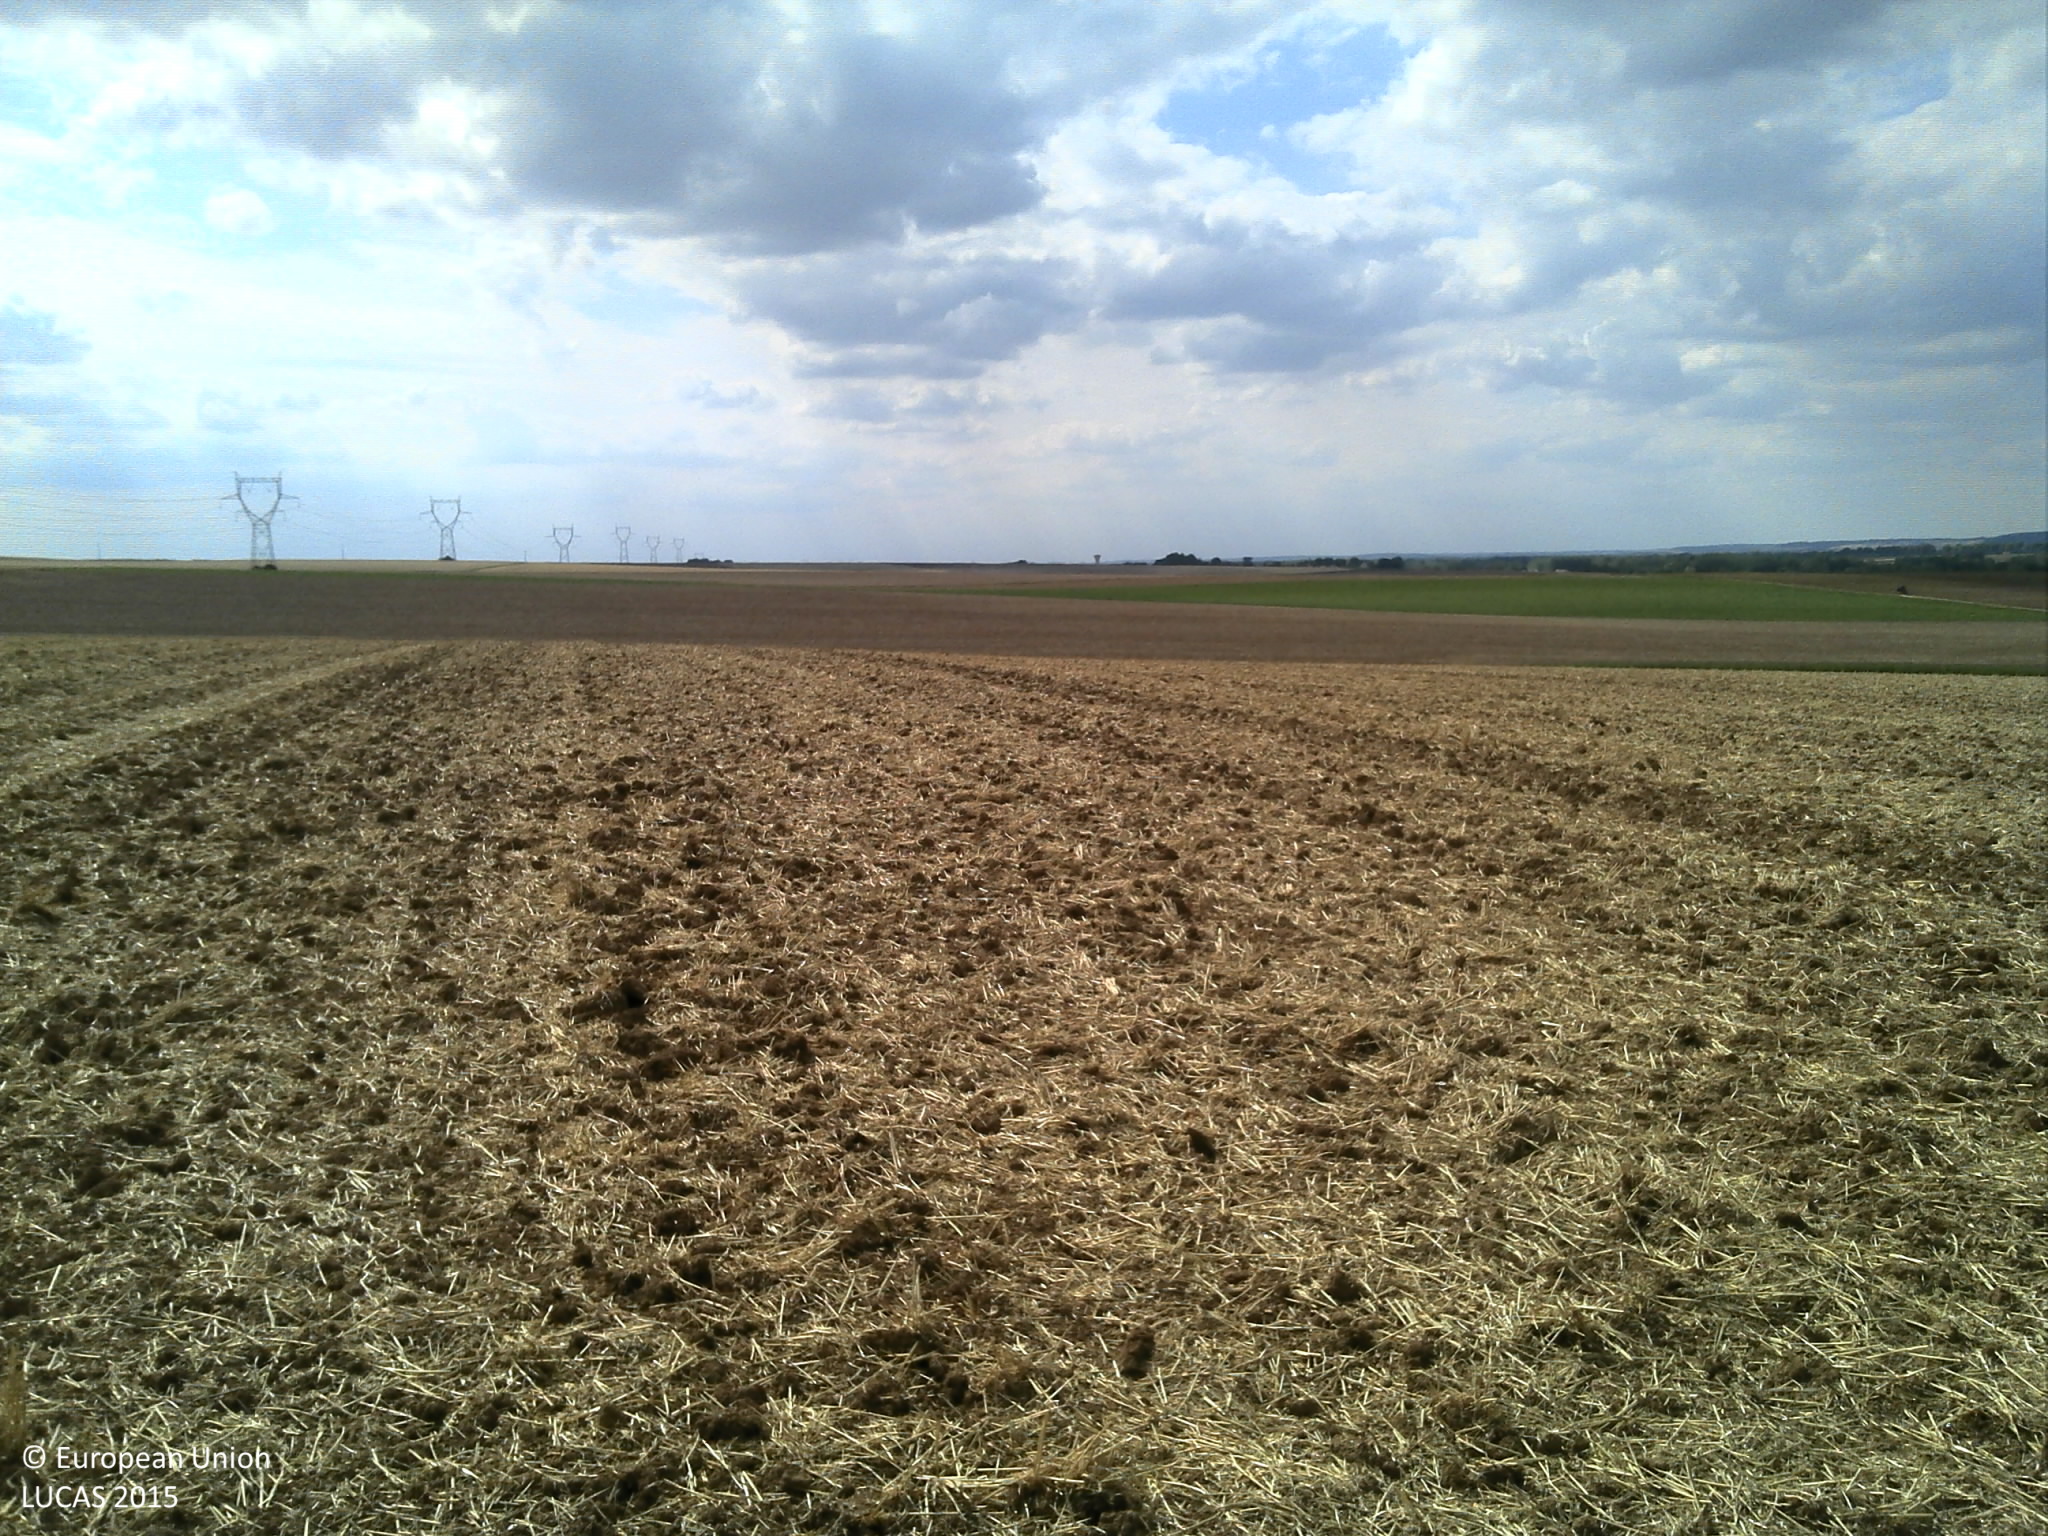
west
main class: Cropland
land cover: Common wheat
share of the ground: 25 - 50 %
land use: Agriculture (excluding fallow land and kitchen gardens)
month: August
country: FR
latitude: 48.4447
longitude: 3.4643
